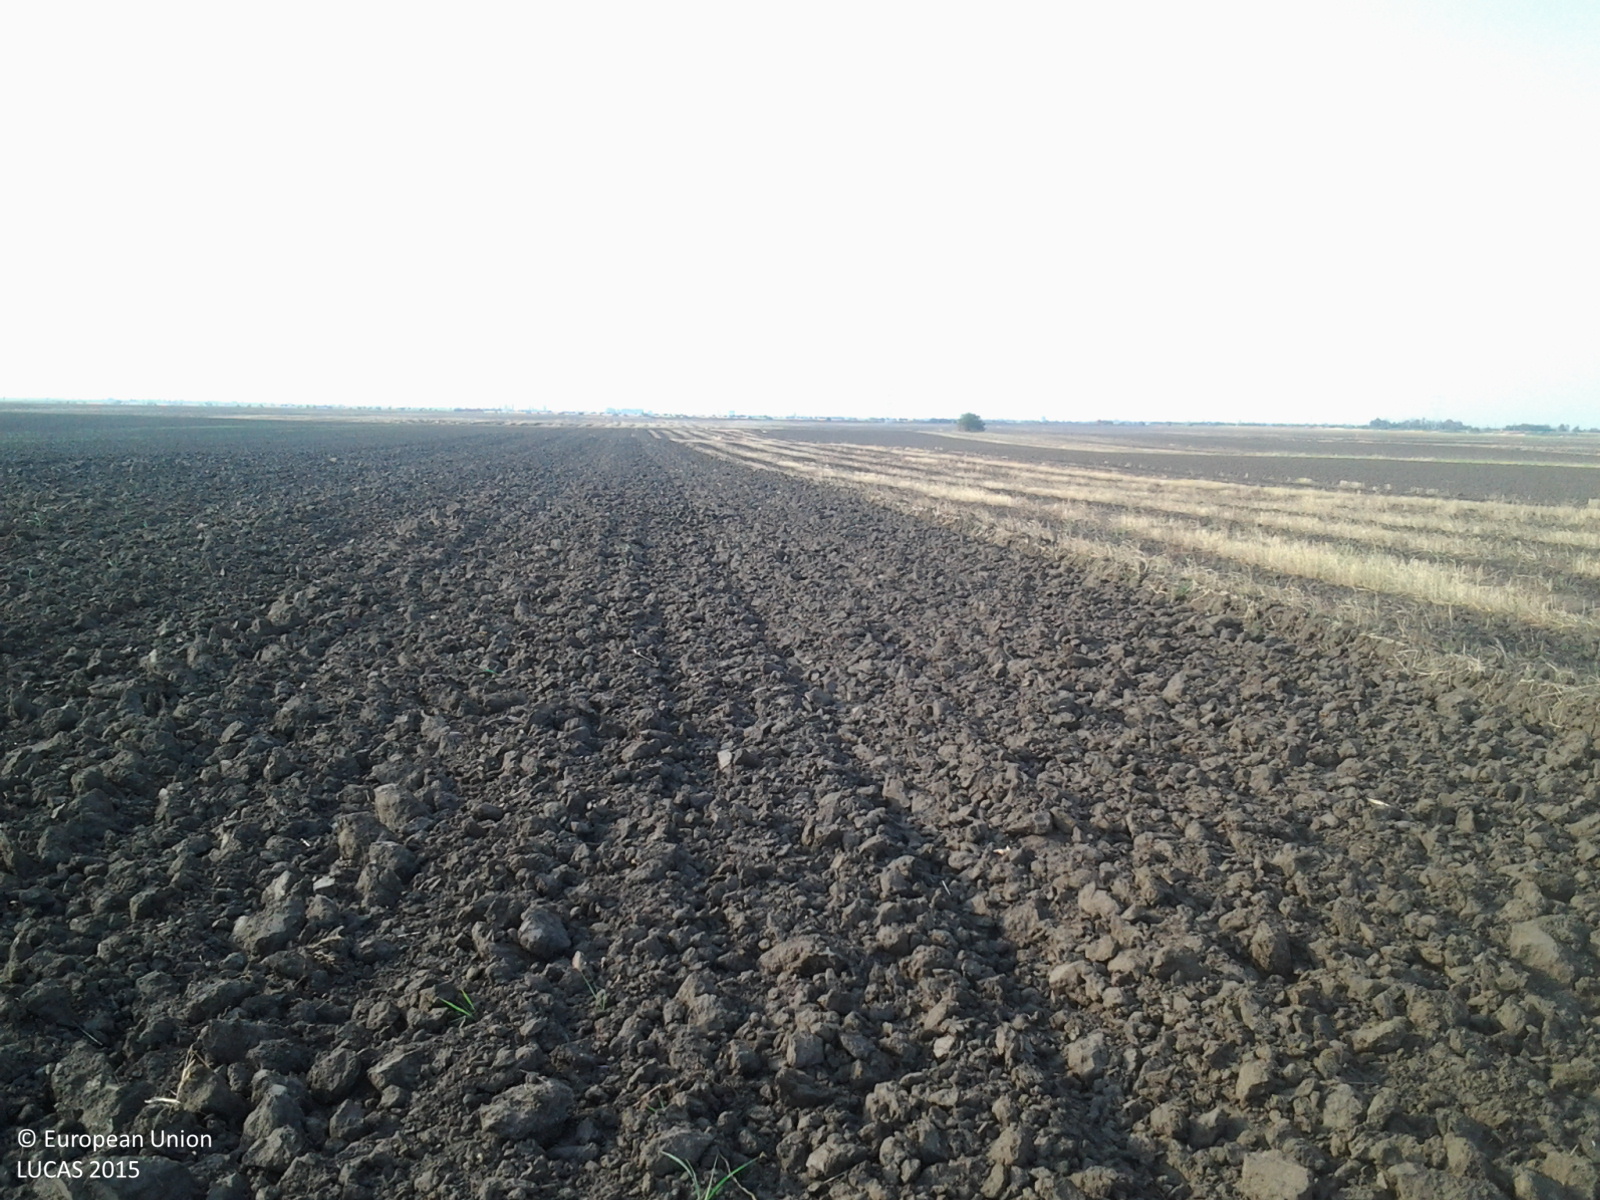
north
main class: Cropland
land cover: Common wheat
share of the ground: < 10 %
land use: Agriculture (excluding fallow land and kitchen gardens)
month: August
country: RO
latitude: 43.9617
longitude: 23.0405
